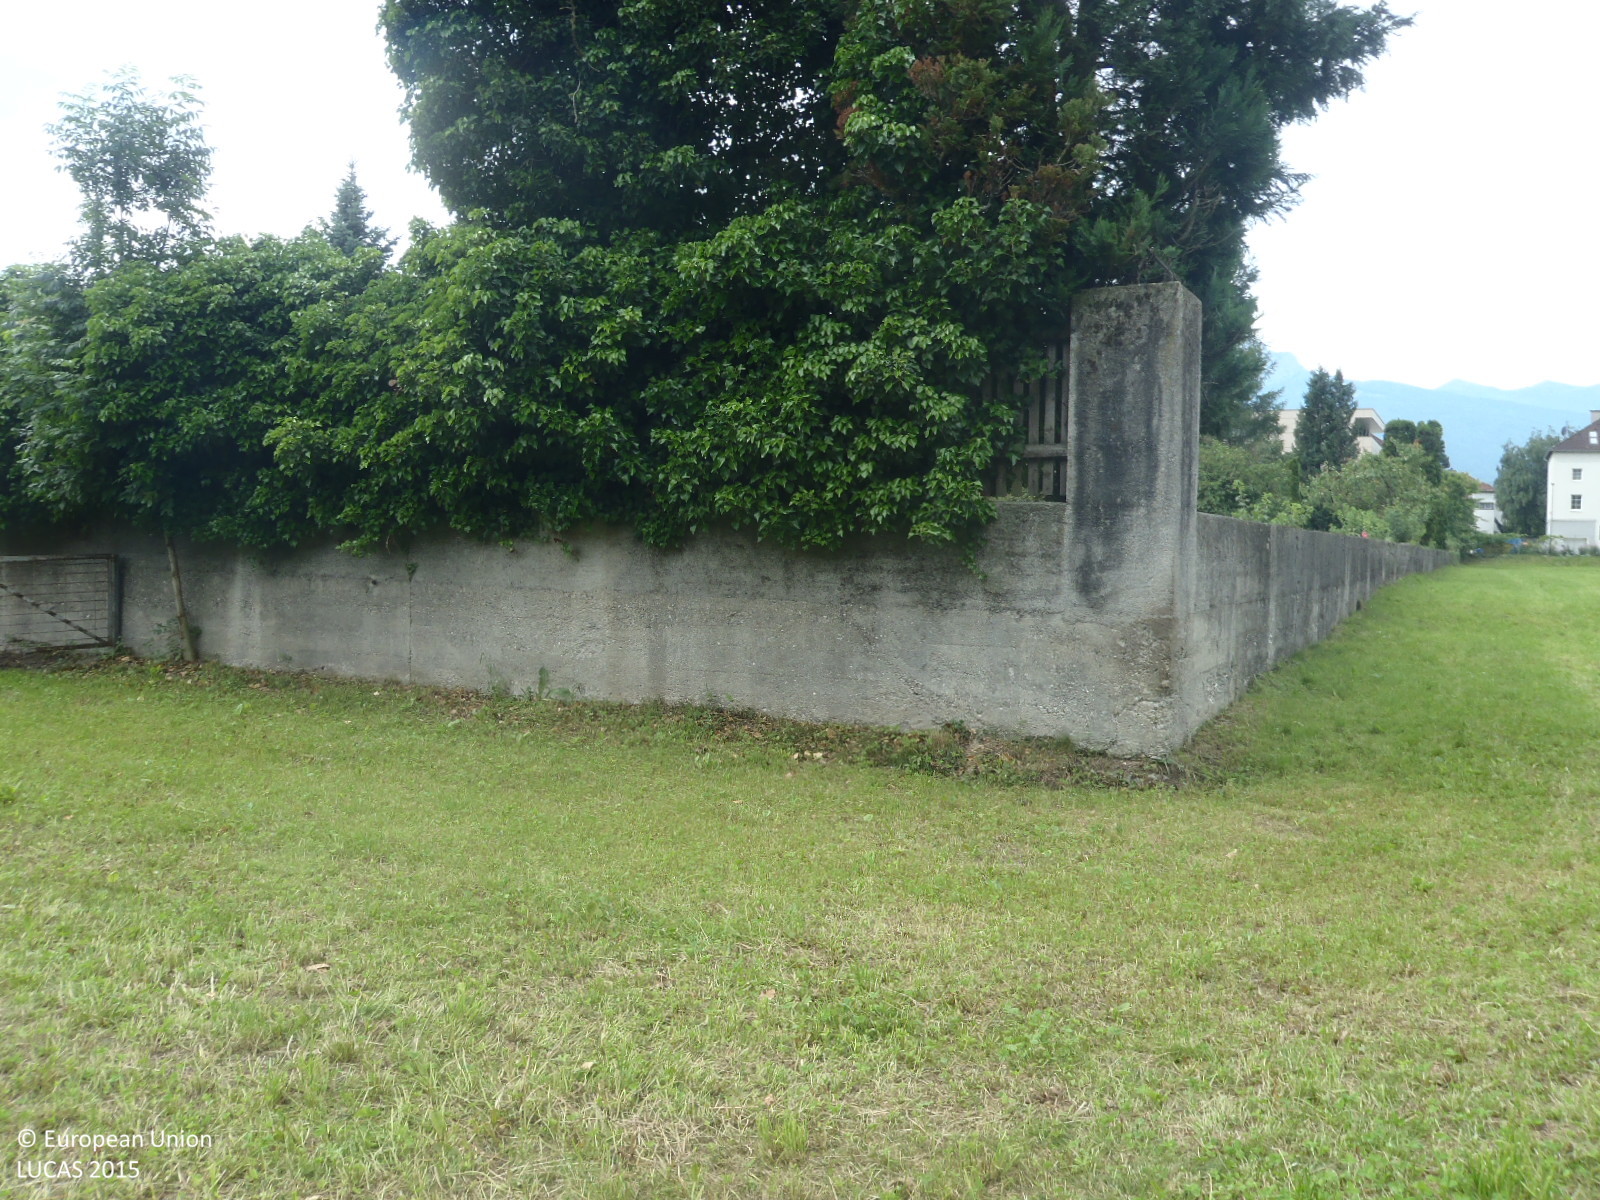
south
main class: Grassland
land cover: Grassland without tree/shrub cover
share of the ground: > 75 %
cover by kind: herbaceous plants 100 %
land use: Agriculture (excluding fallow land and kitchen gardens)
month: June
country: AT
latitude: 47.2784
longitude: 11.4132
